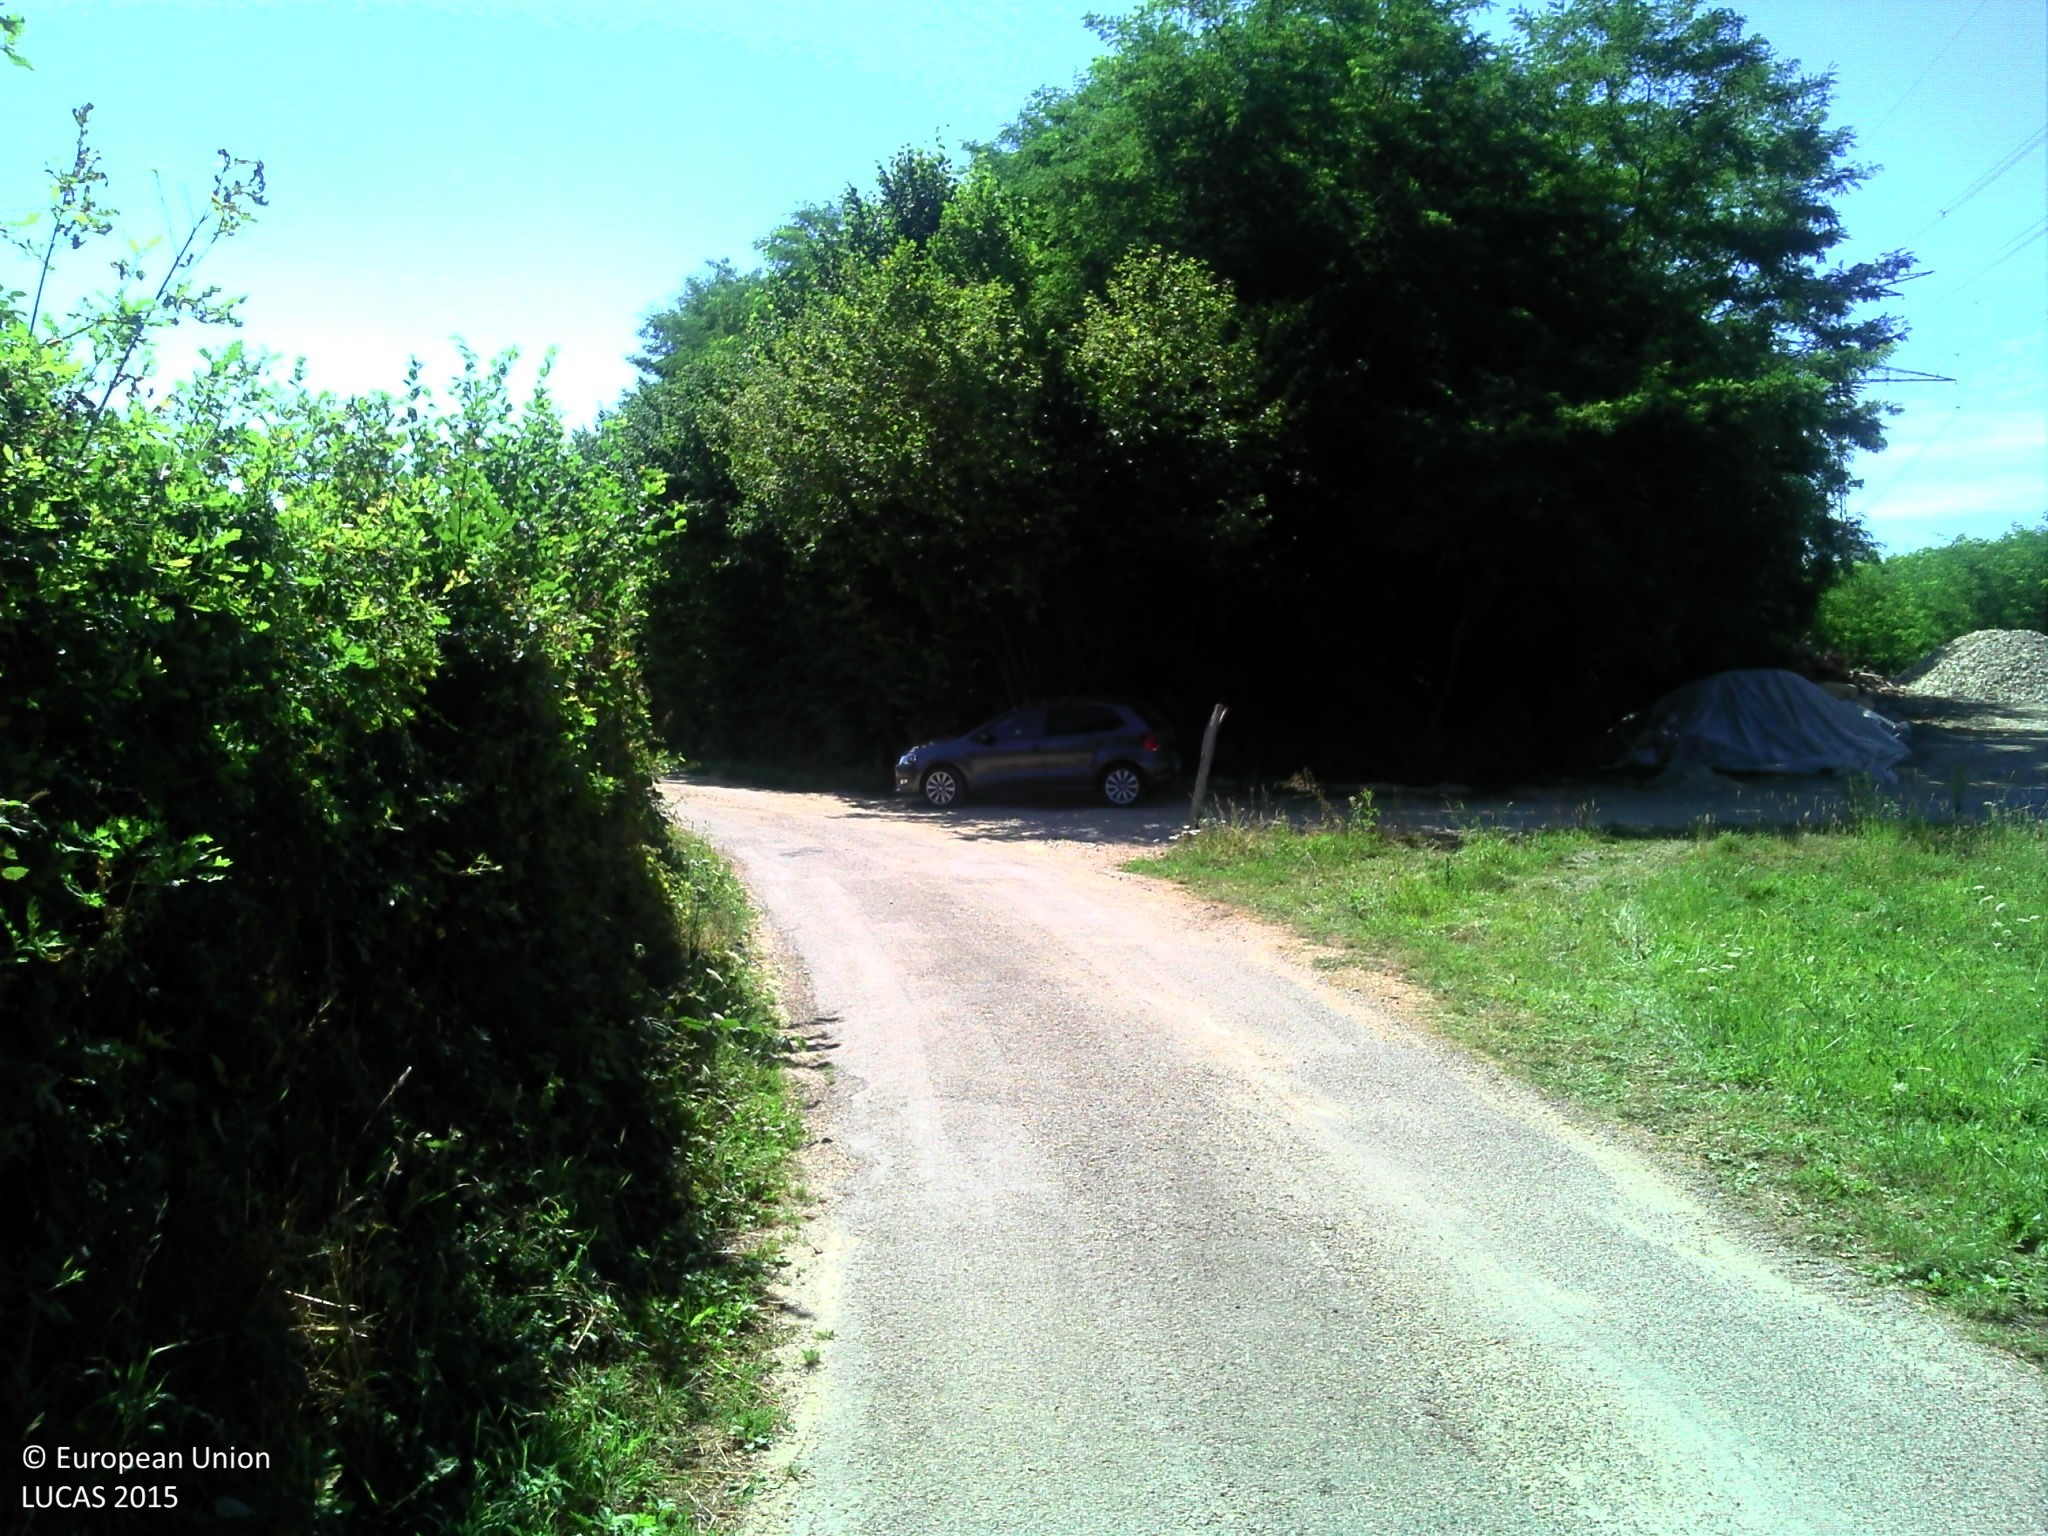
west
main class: Grassland
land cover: Grassland without tree/shrub cover
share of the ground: > 75 %
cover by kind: herbaceous plants 100 %
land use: Agriculture (excluding fallow land and kitchen gardens)
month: July
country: FR
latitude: 45.6050
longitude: 5.4528
